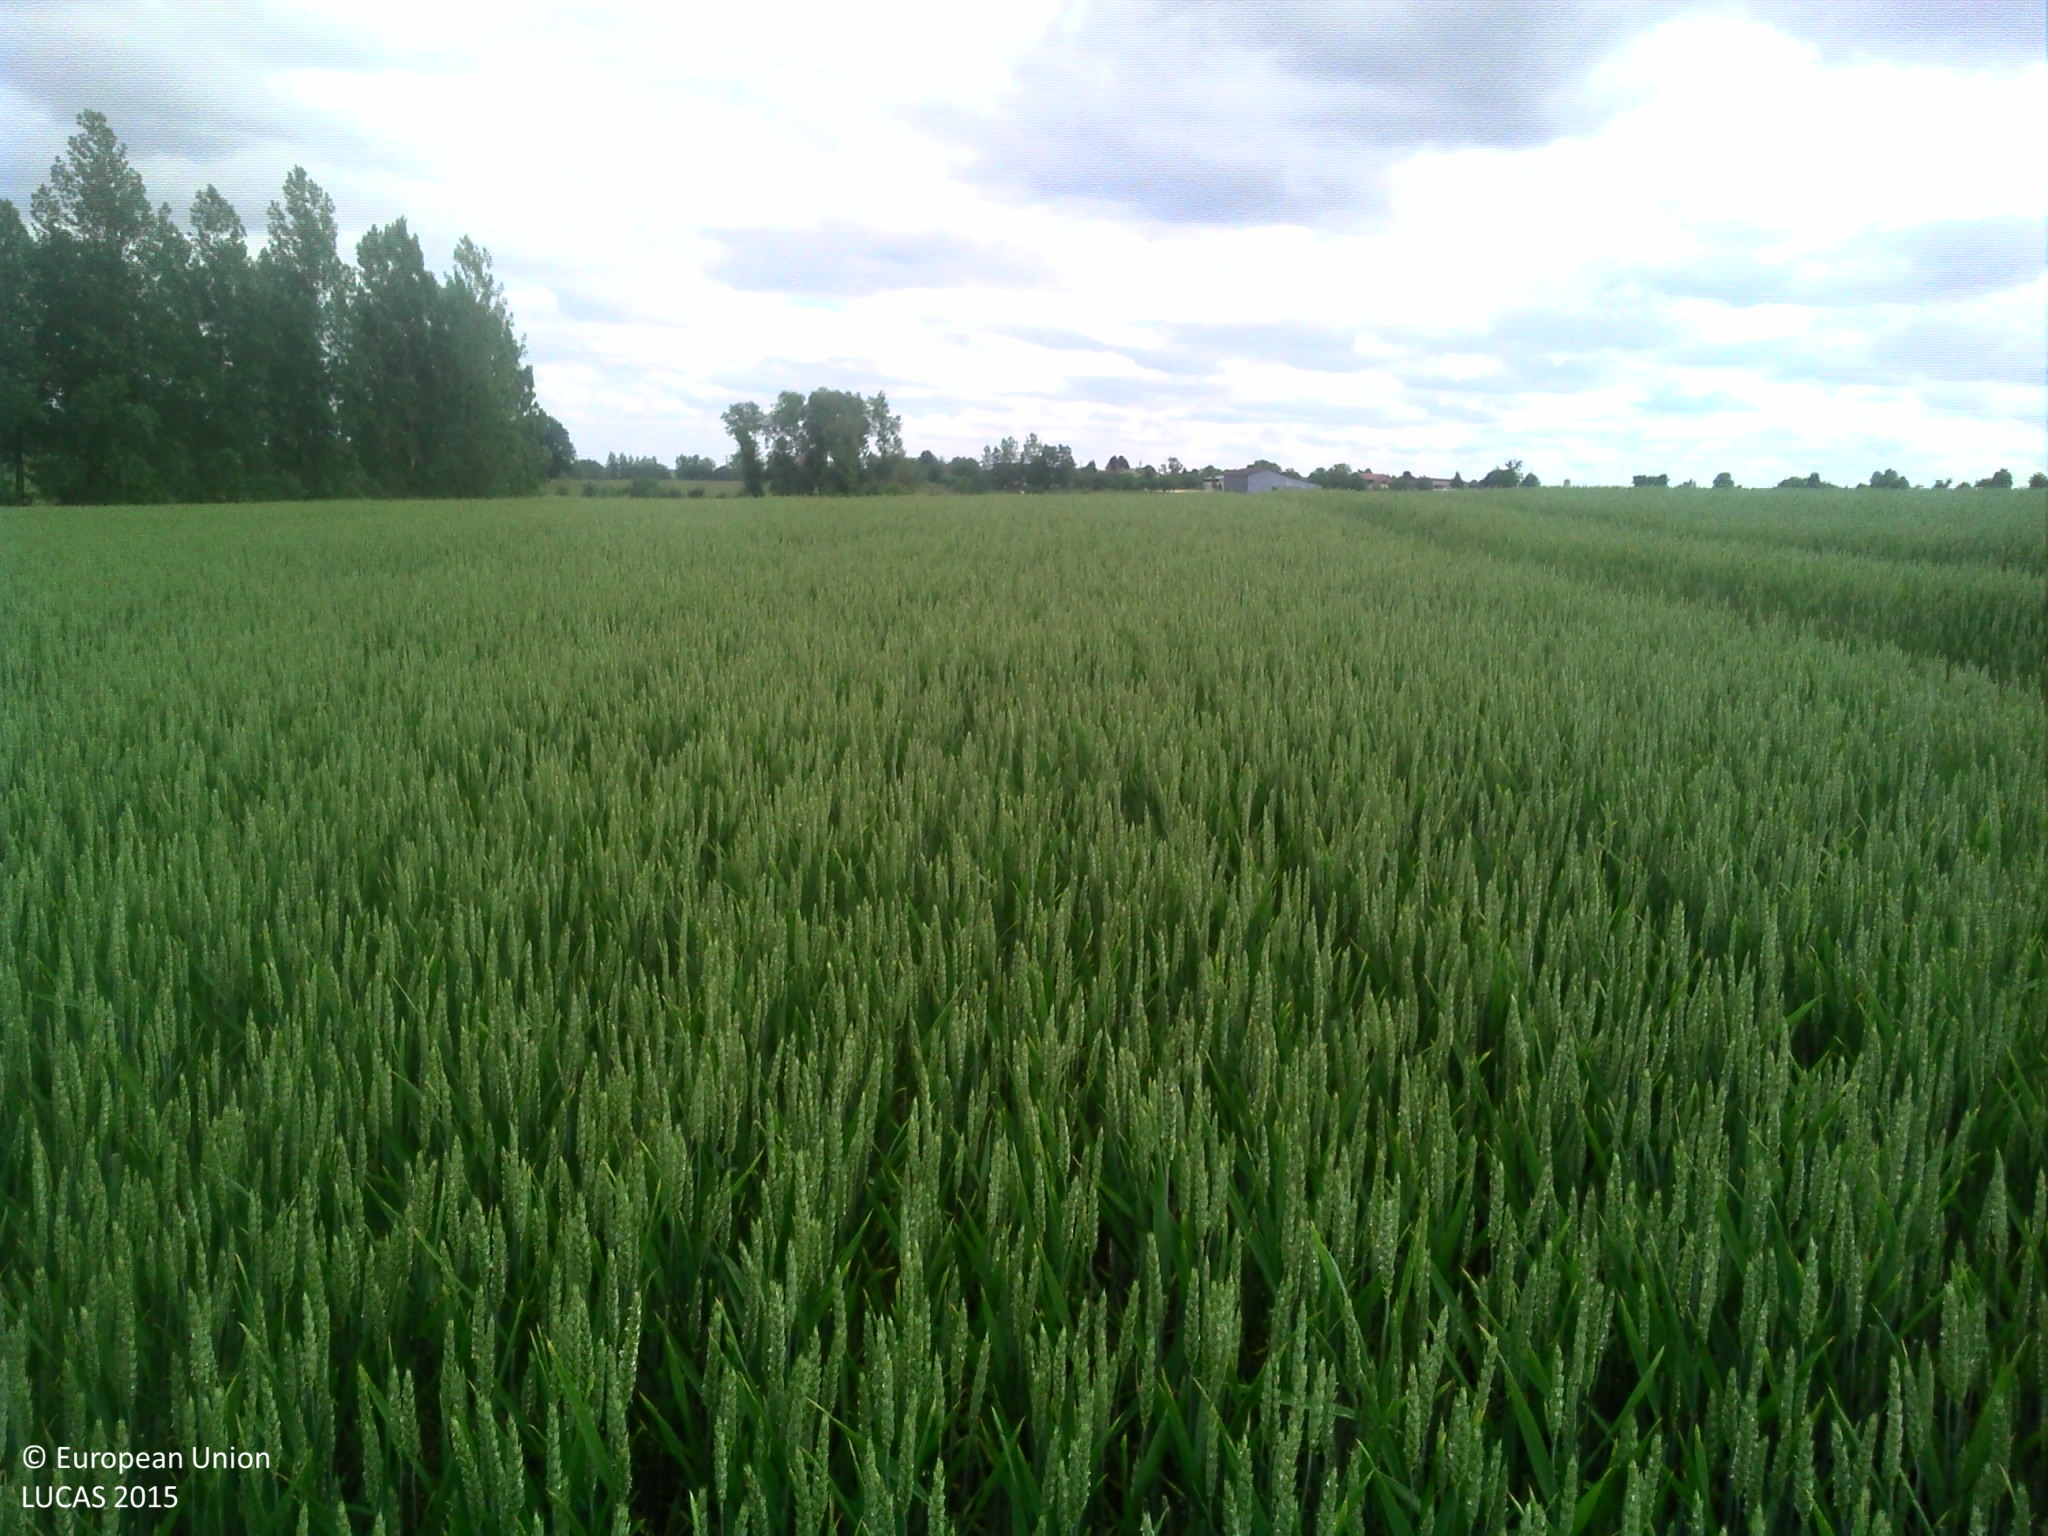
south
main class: Cropland
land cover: Common wheat
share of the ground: > 75 %
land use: Agriculture (excluding fallow land and kitchen gardens)
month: June
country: FR
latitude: 48.5290
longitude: 4.7030
